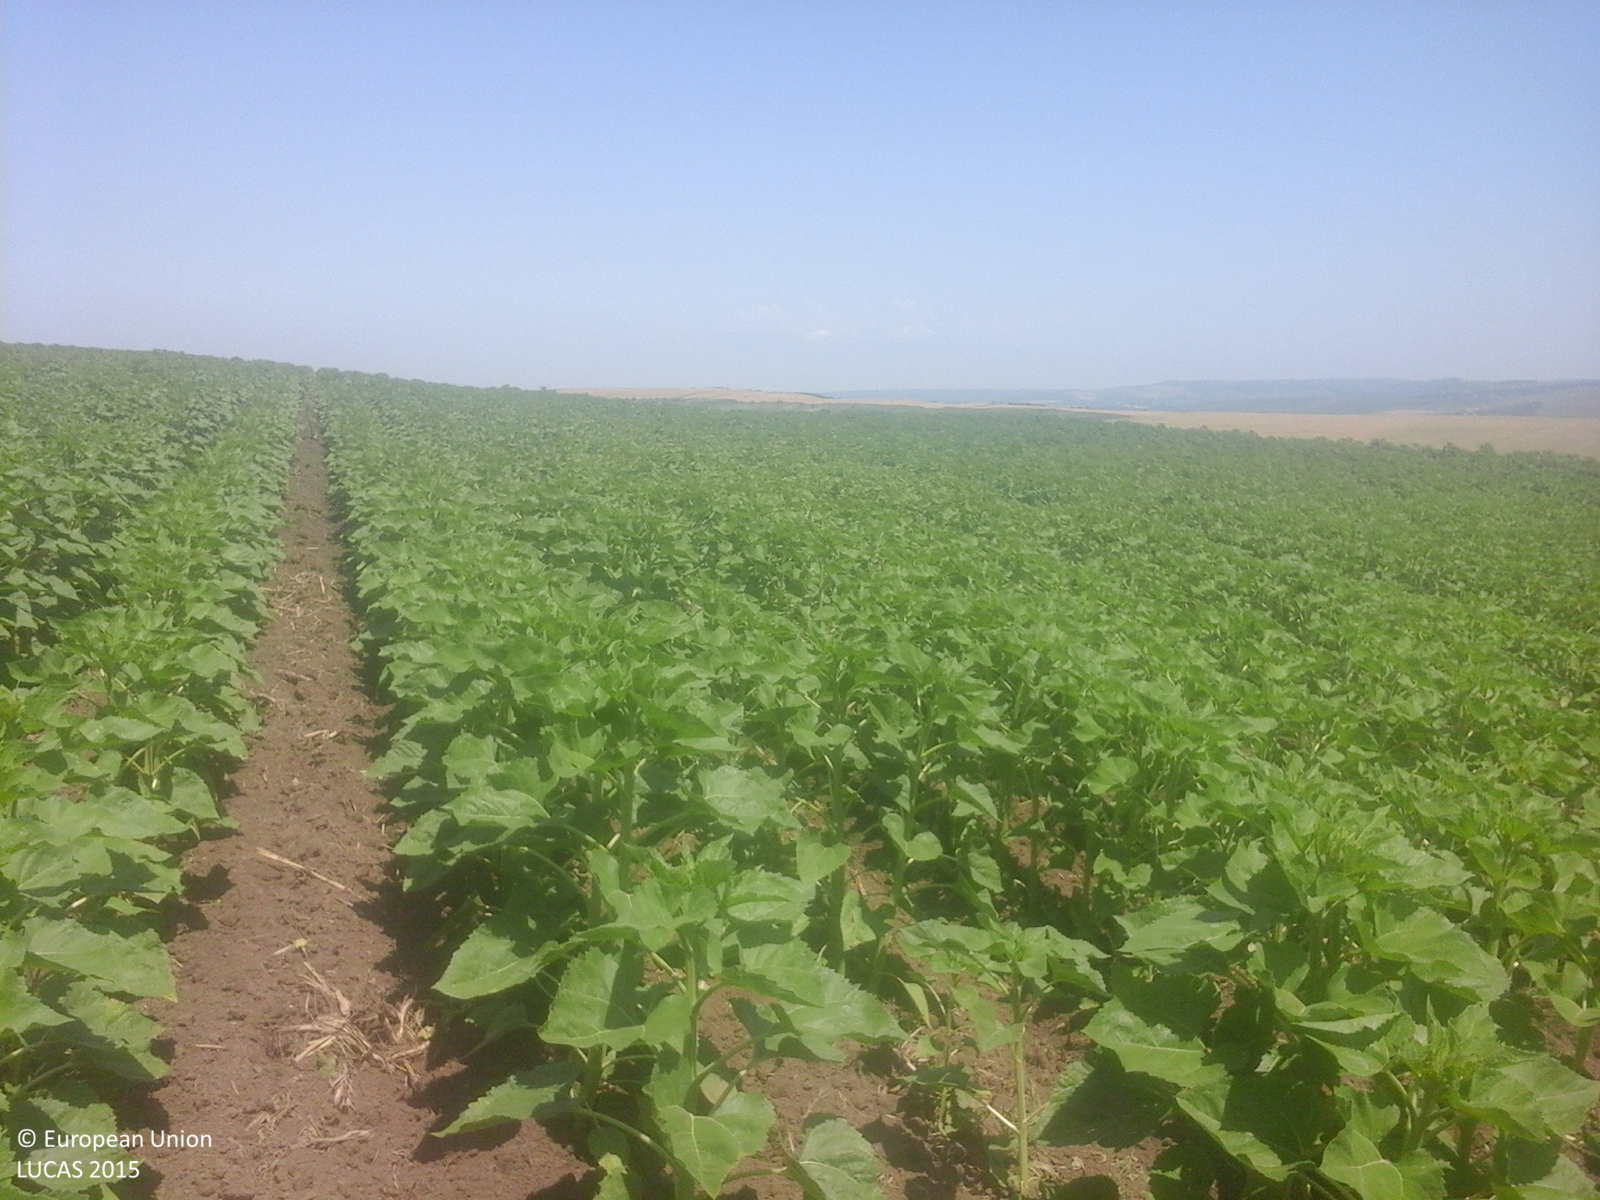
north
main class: Cropland
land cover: Sunflower
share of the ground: > 75 %
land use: Agriculture (excluding fallow land and kitchen gardens)
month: June
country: RO
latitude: 46.8391
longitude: 27.5403
